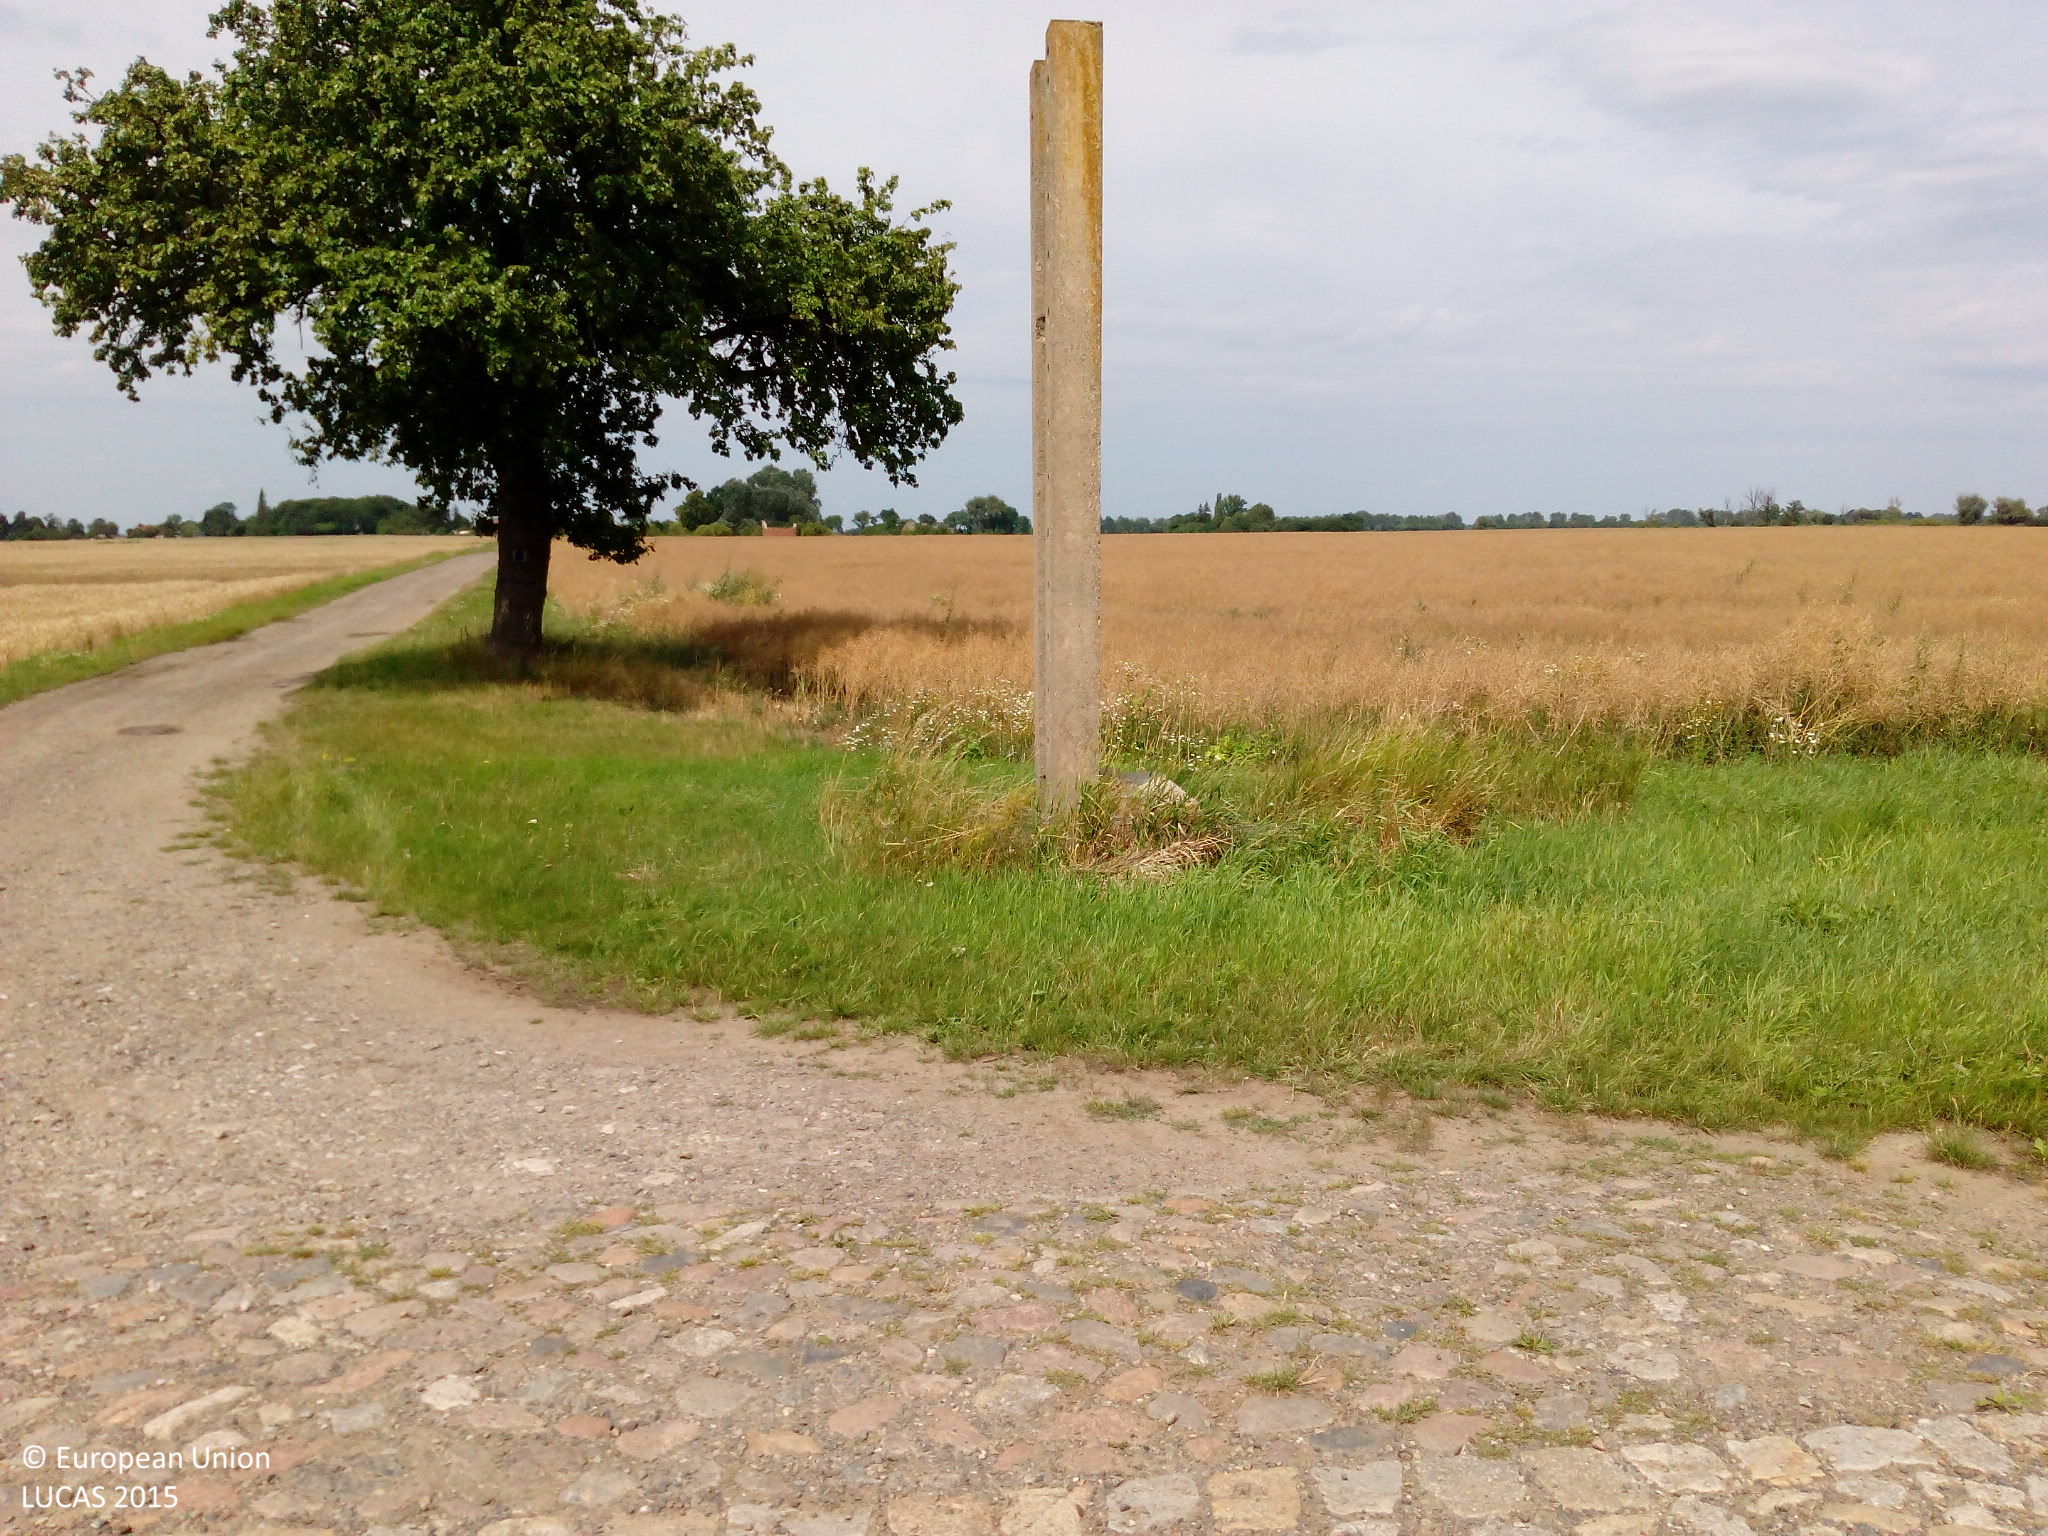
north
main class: Cropland
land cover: Common wheat
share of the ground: > 75 %
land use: Agriculture (excluding fallow land and kitchen gardens)
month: July
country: DE
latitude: 52.5645
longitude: 14.4419
